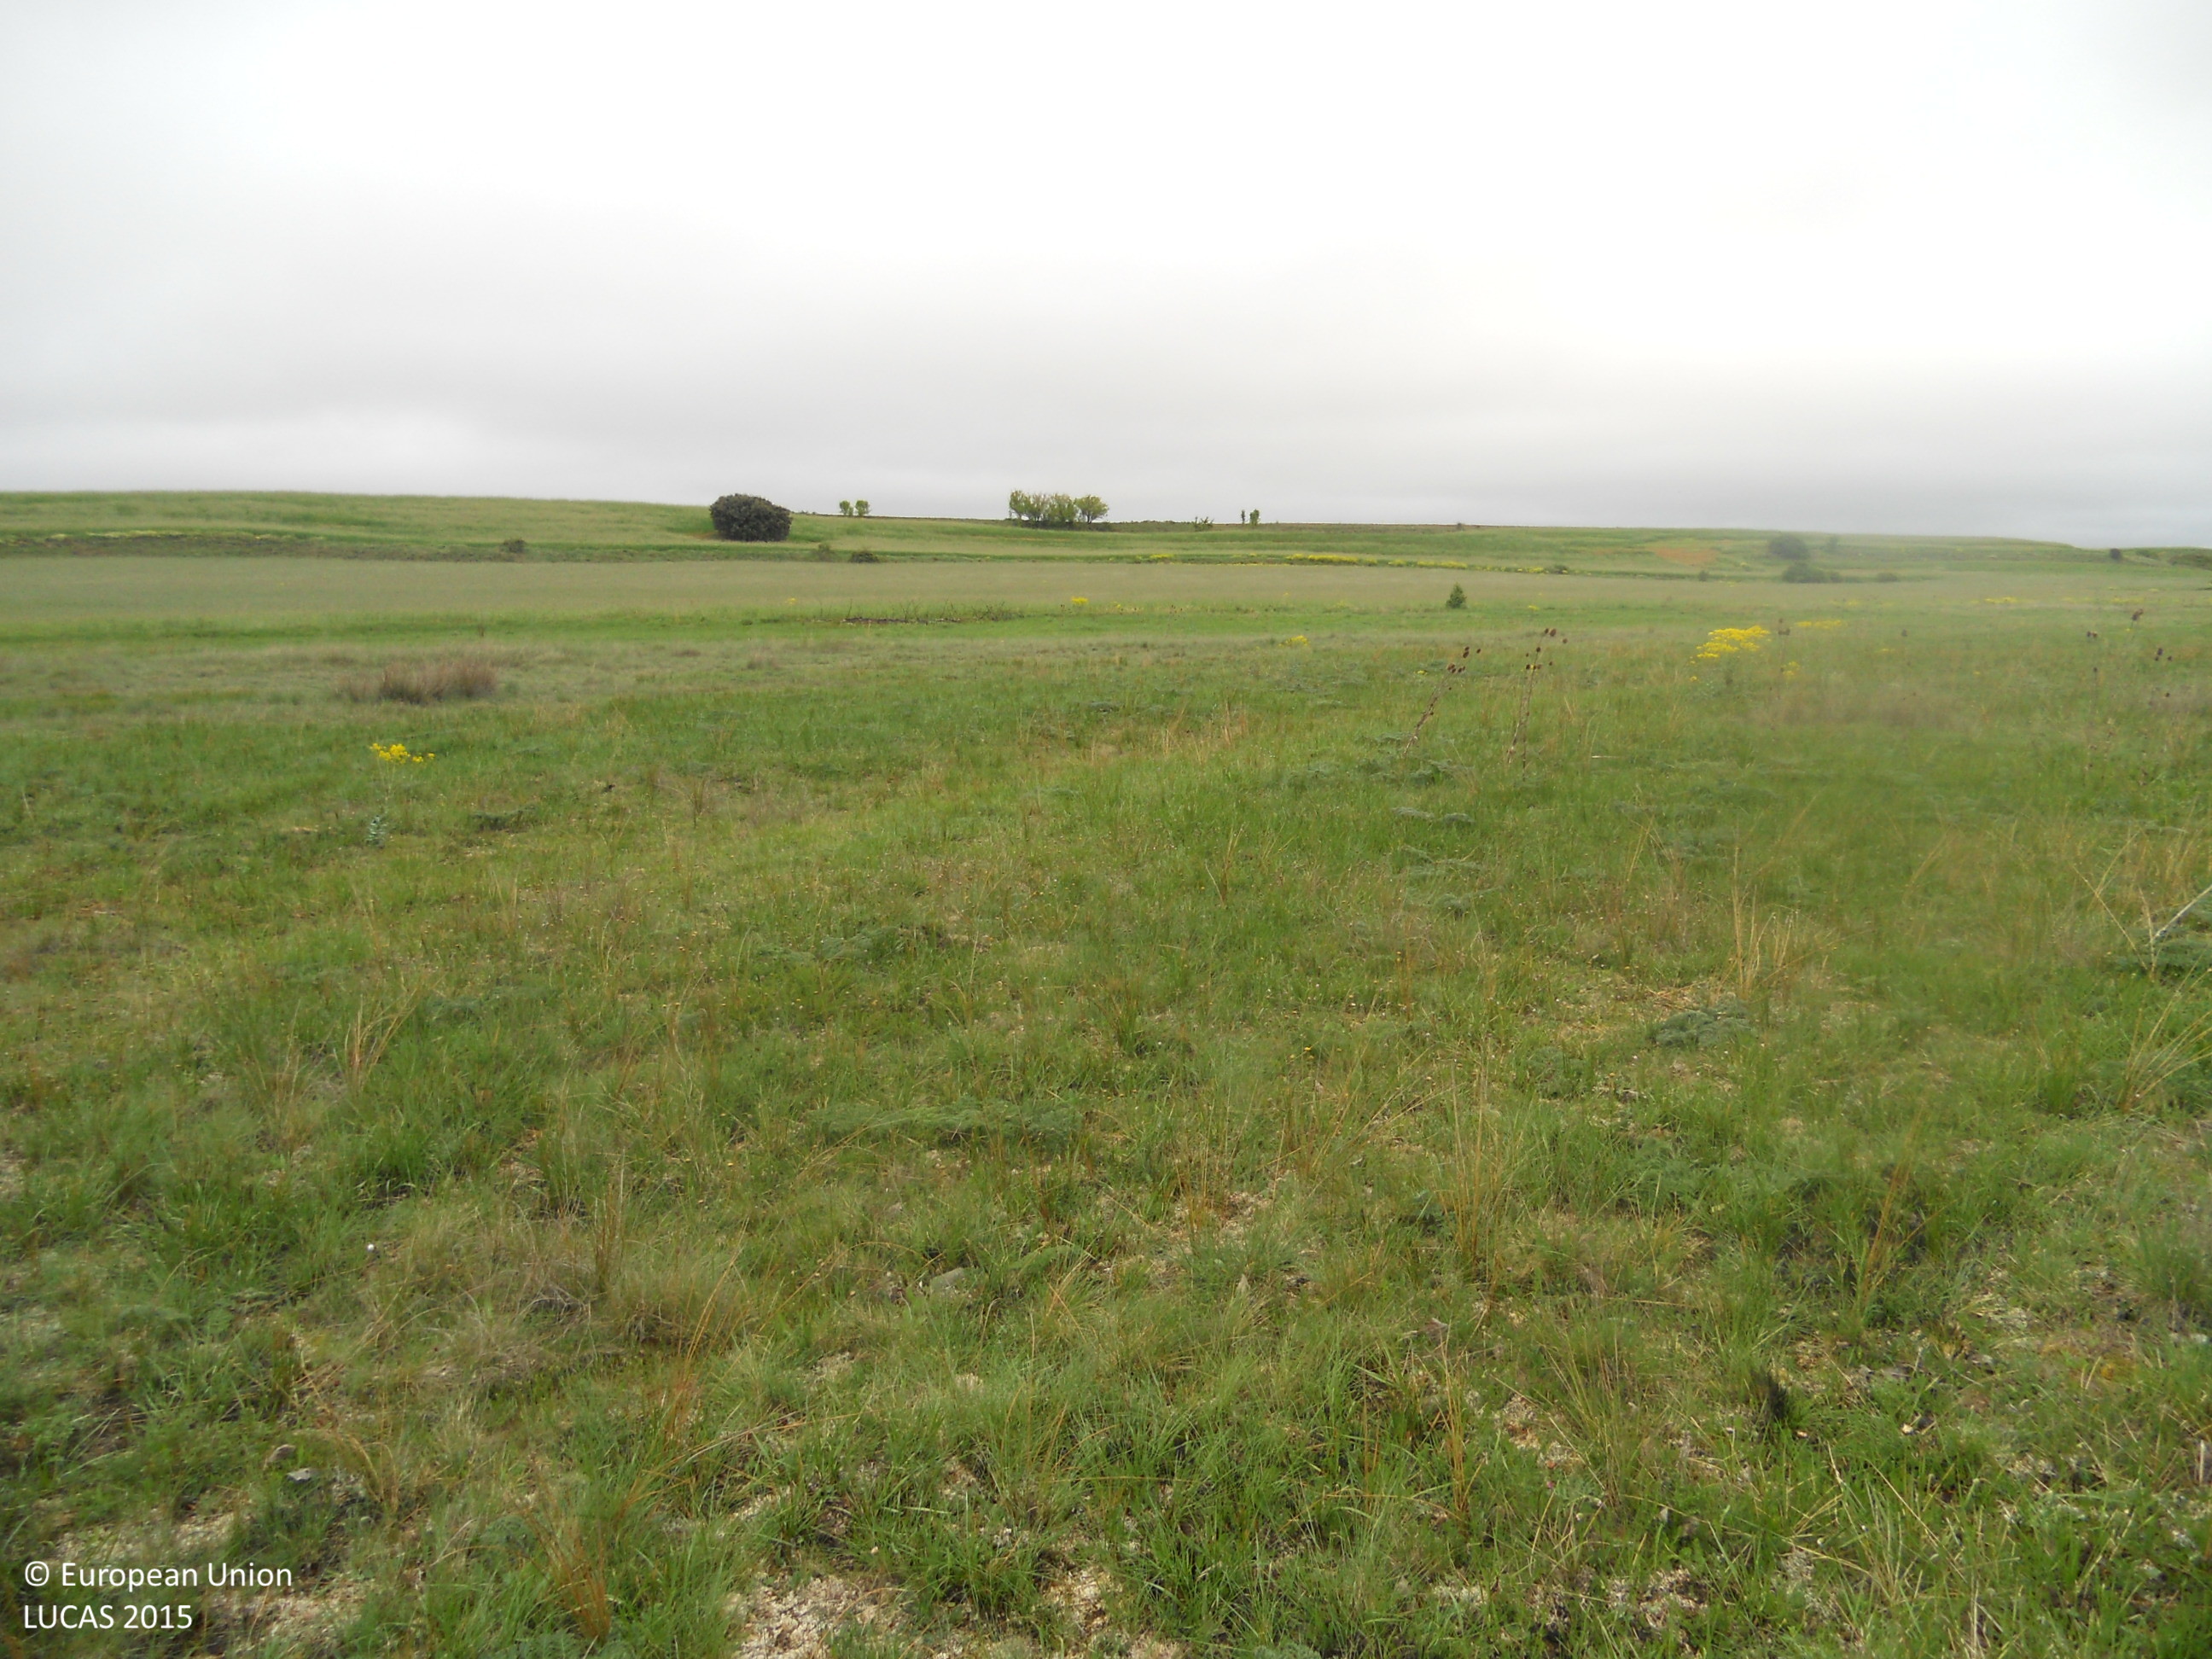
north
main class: Grassland
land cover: Grassland without tree/shrub cover
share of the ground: > 75 %
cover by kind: herbaceous plants 95 %, shrubs 5 %
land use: Agriculture (excluding fallow land and kitchen gardens)
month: May
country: ES
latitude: 42.4697
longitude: -5.3305
